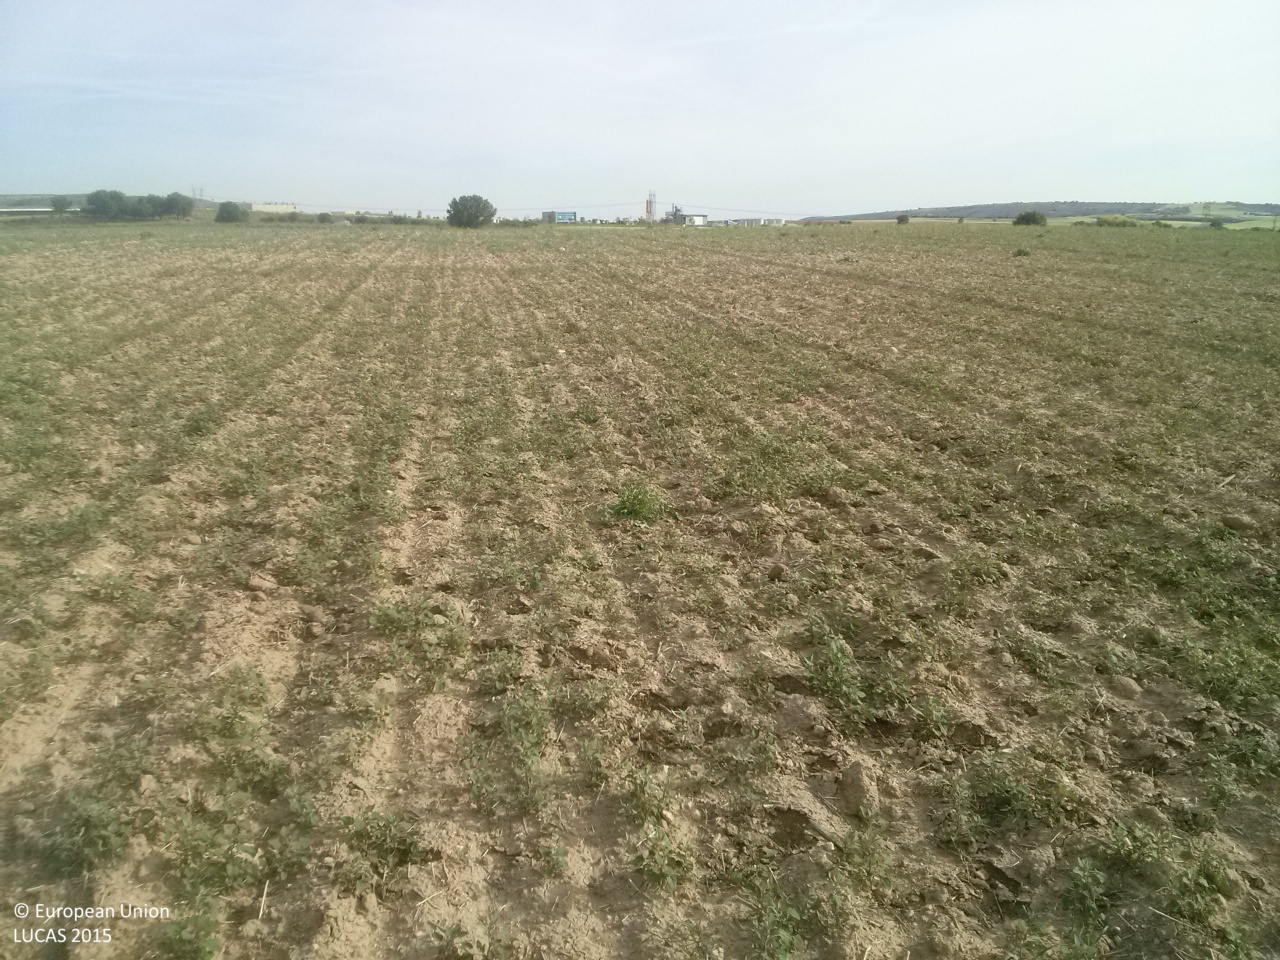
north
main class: Grassland
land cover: Spontaneously vegetated surfaces
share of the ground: 25 - 50 %
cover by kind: unconsolidated bare surface 75 %, herbaceous plants 25 %
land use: Fallow land
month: May
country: ES
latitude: 39.8827
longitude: -2.6590
